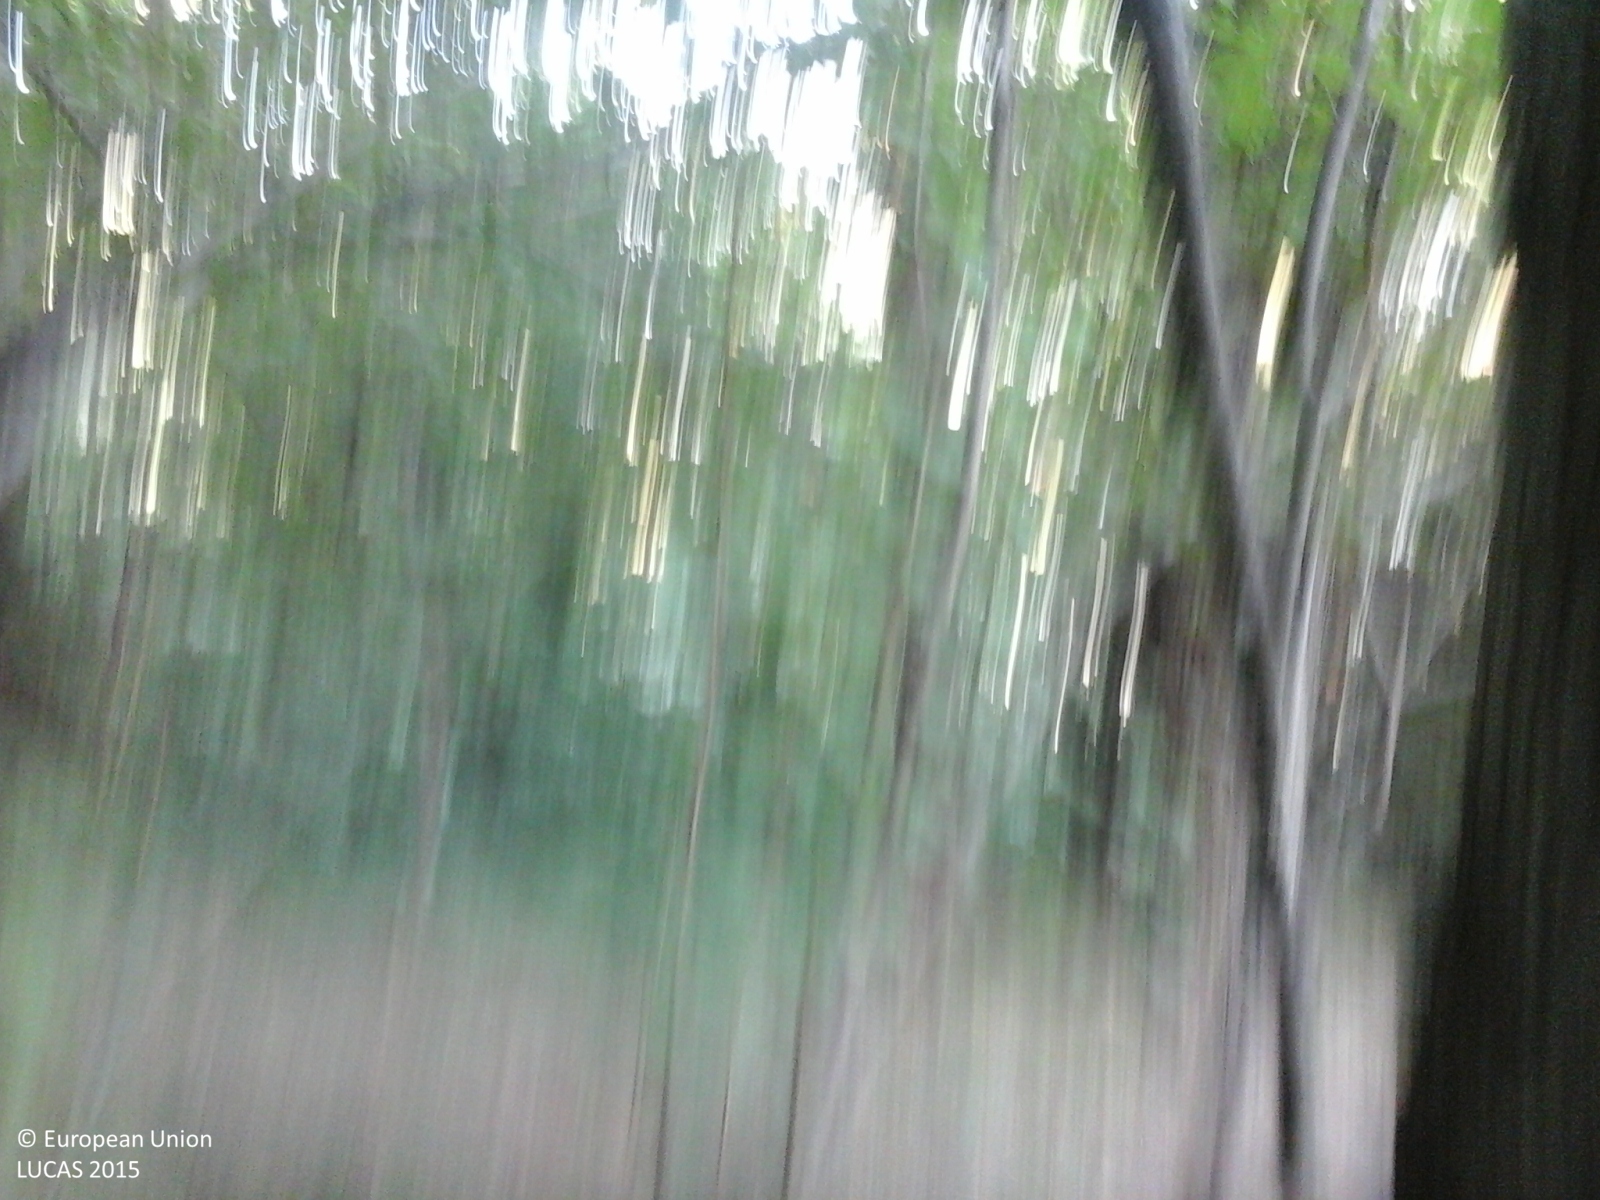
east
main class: Woodland
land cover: Broadleaved woodland
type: mountainous beech forest
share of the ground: > 75 %
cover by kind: broadleaved forest trees 100 %
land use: Semi-natural and natural areas not in use
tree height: > 5 m
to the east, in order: Broadleaved woodland; Tracks; Broadleaved woodland; Tracks; Broadleaved woodland; Rivers and streams; Broadleaved woodland
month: July
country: IT
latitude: 46.2429
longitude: 10.2202
